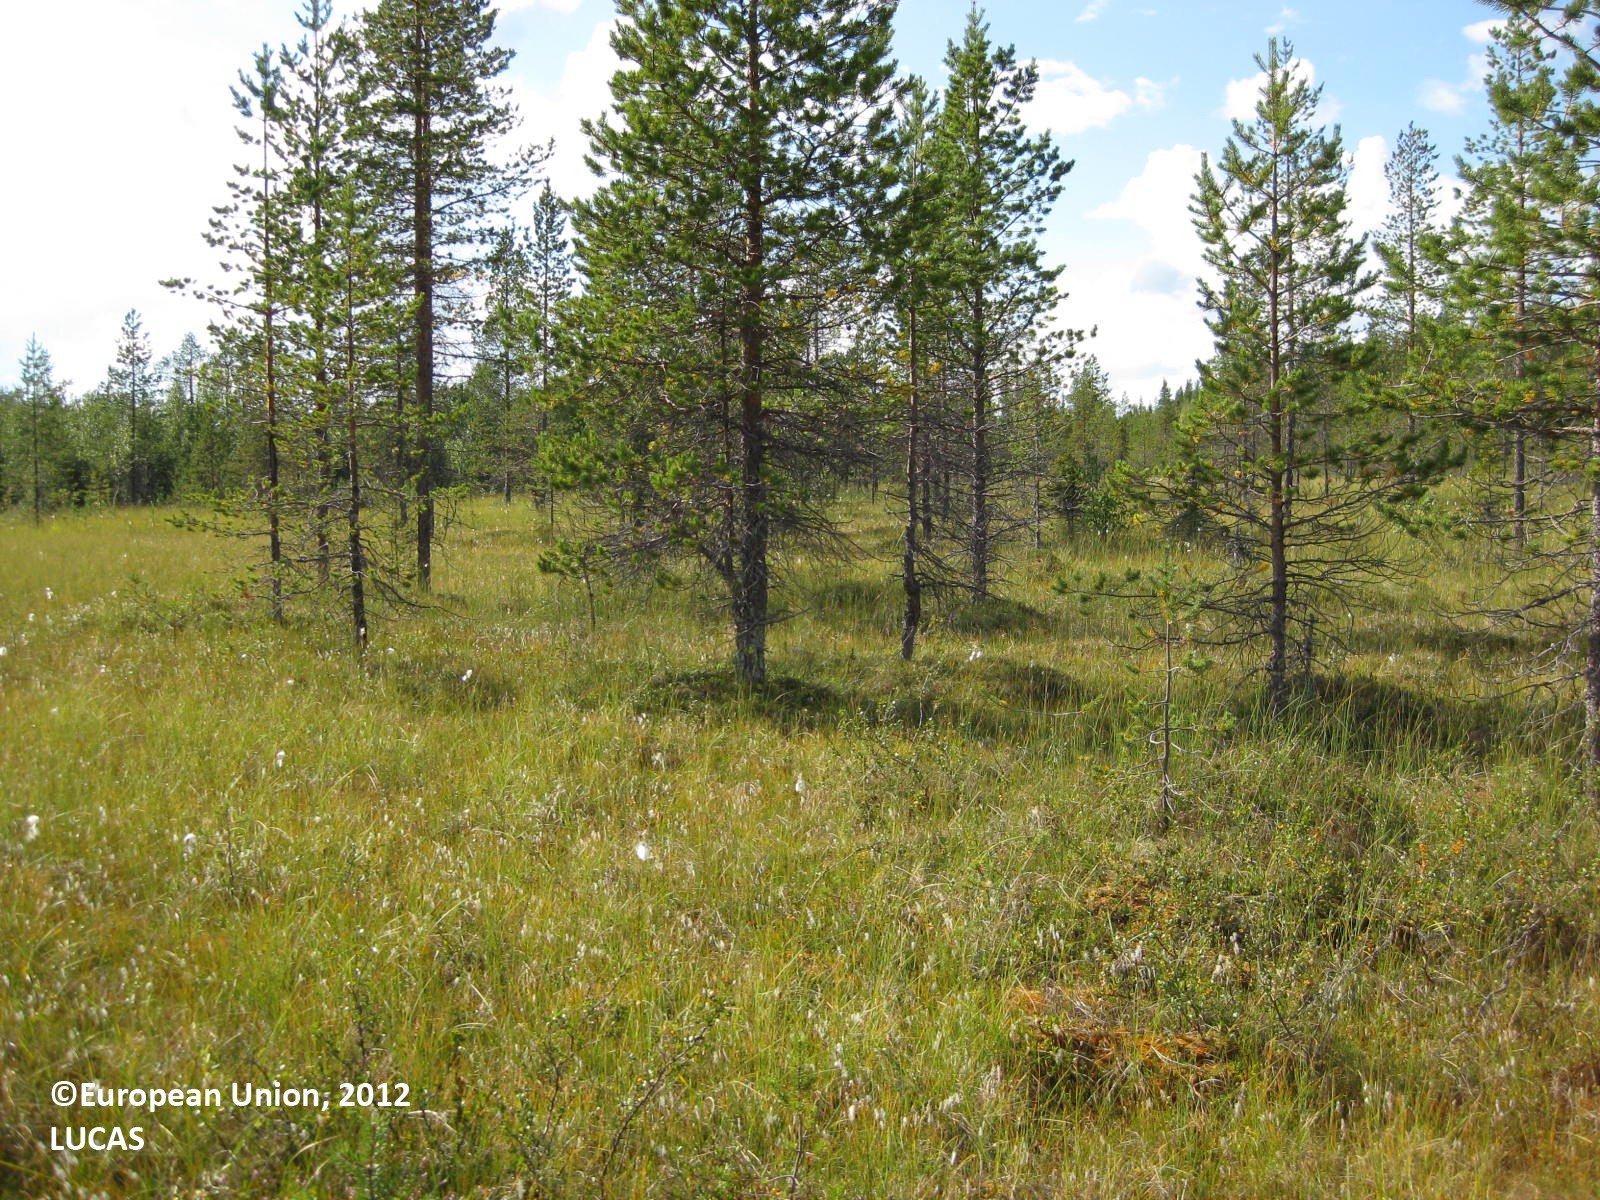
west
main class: Woodland
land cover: Pine dominated coniferous woodland
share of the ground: 25 - 50 %
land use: Semi-natural and natural areas not in use
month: August
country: FI
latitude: 66.4124
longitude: 29.0458
